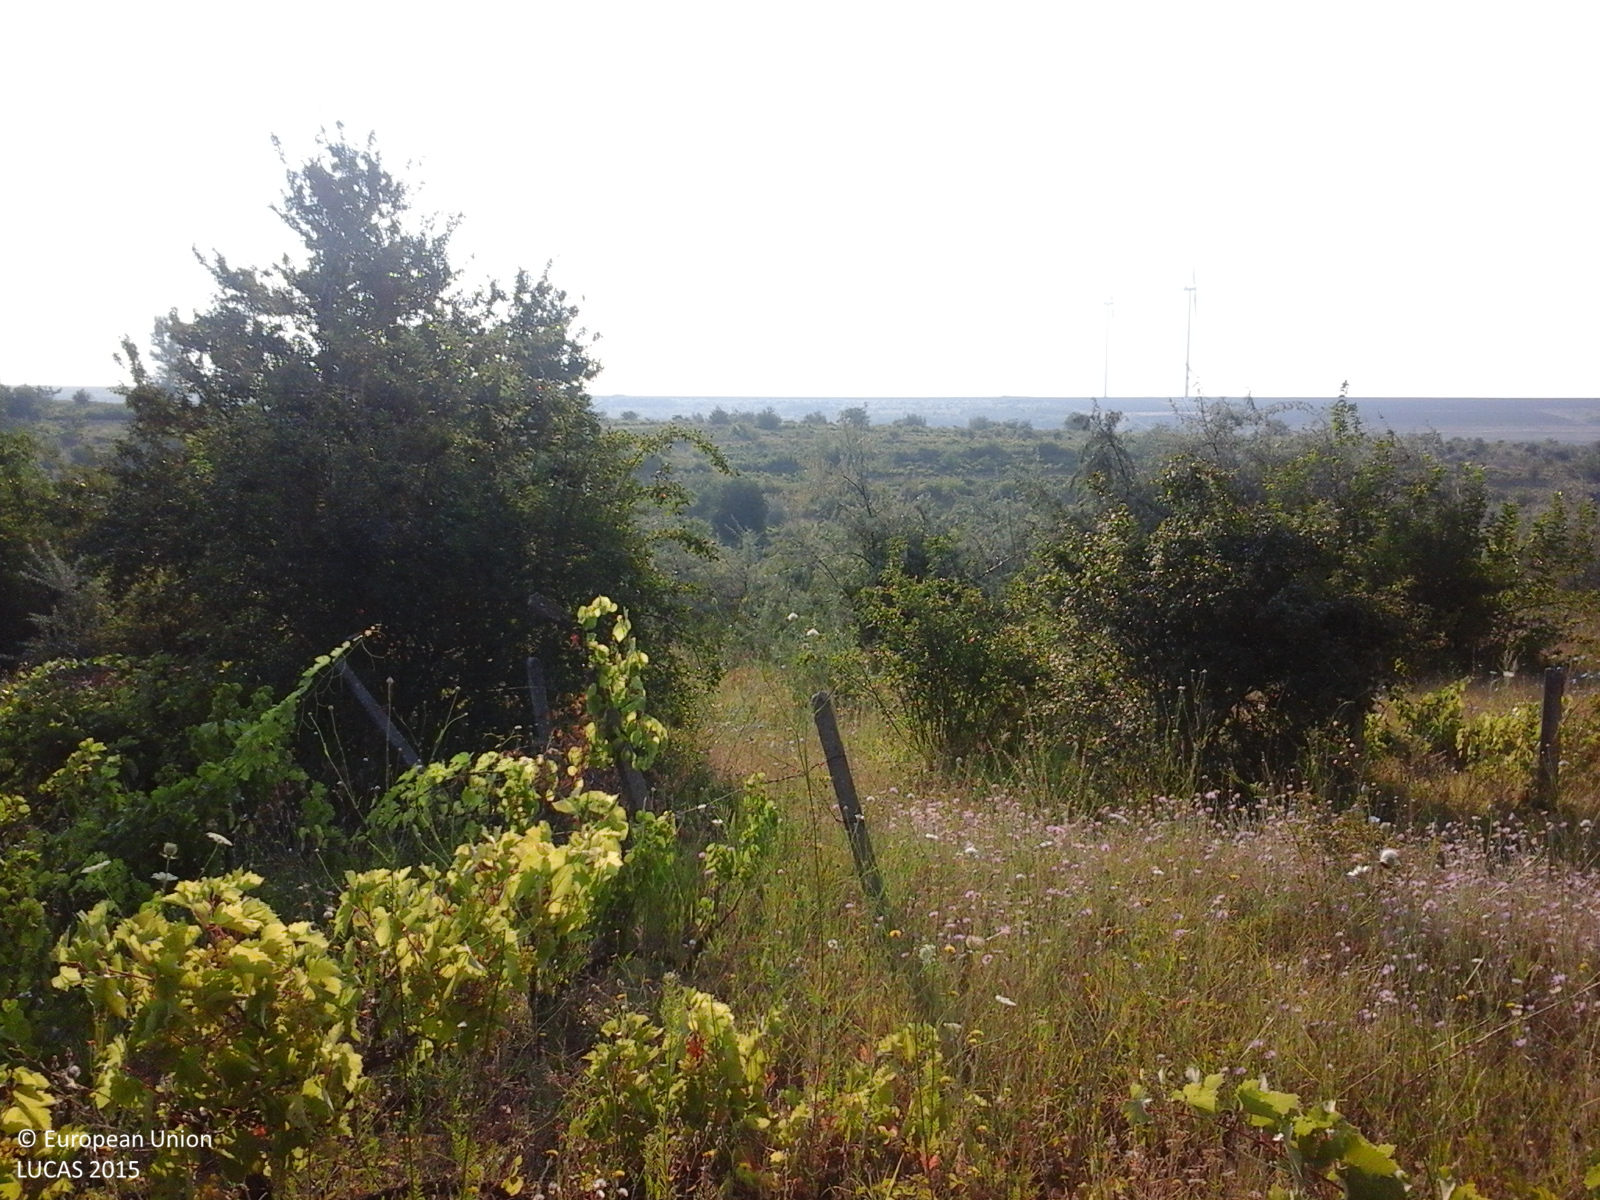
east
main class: Cropland
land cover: Vineyards
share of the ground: > 75 %
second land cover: Grassland without tree/shrub cover
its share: > 75 %
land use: Agriculture (excluding fallow land and kitchen gardens)
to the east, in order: Vineyards; Grassland without tree/shrub cover; Tracks; Grassland with sparse tree/shrub cover; Vineyards; Abandoned hedges; Tracks; Vineyards; Lucerne; Maize; Vineyards; Abandoned hedges; Vineyards; Abandoned hedges; Vineyards
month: July
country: RO
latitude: 45.8476
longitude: 27.7415
